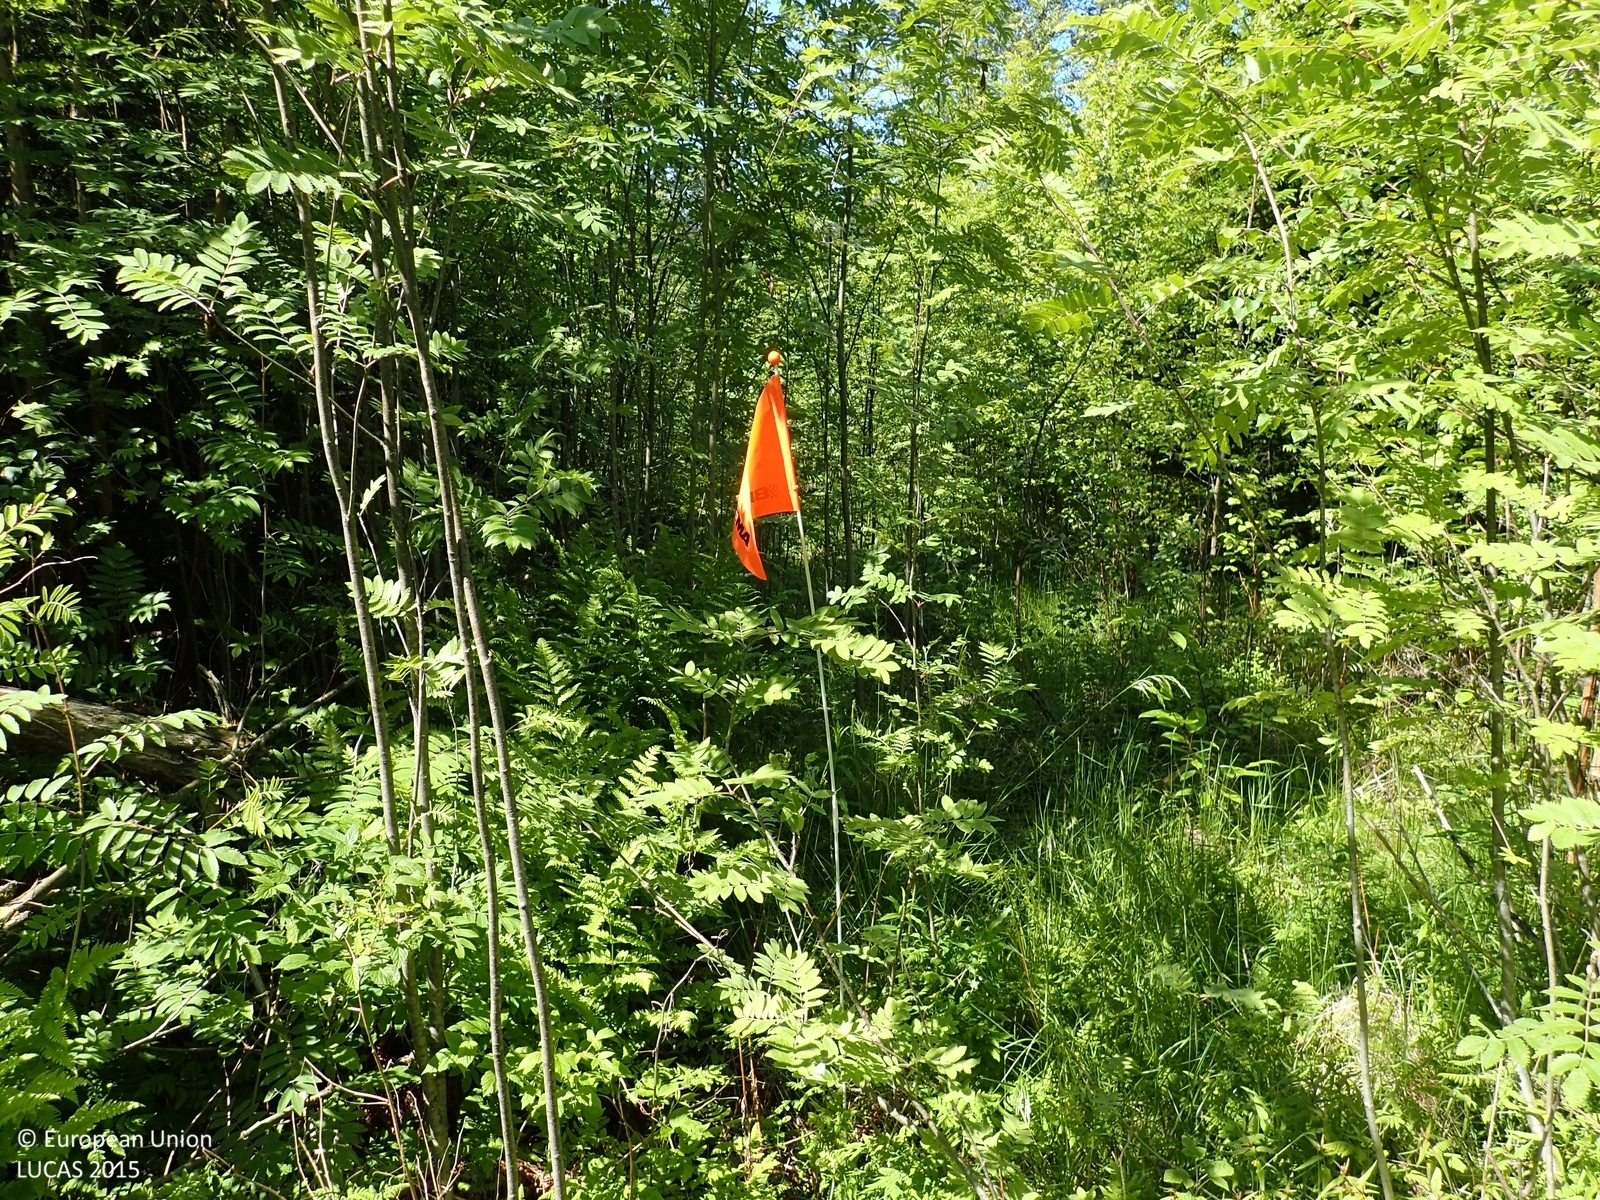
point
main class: Woodland
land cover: Other mixed woodland
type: boreal forest
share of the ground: 50 - 75 %
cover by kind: coniferous forest trees 35 %, herbaceous plants 35 %, broadleaved forest trees 30 %
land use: Forestry
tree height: > 5 m
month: June
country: FI
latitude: 62.4590
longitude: 21.3048
